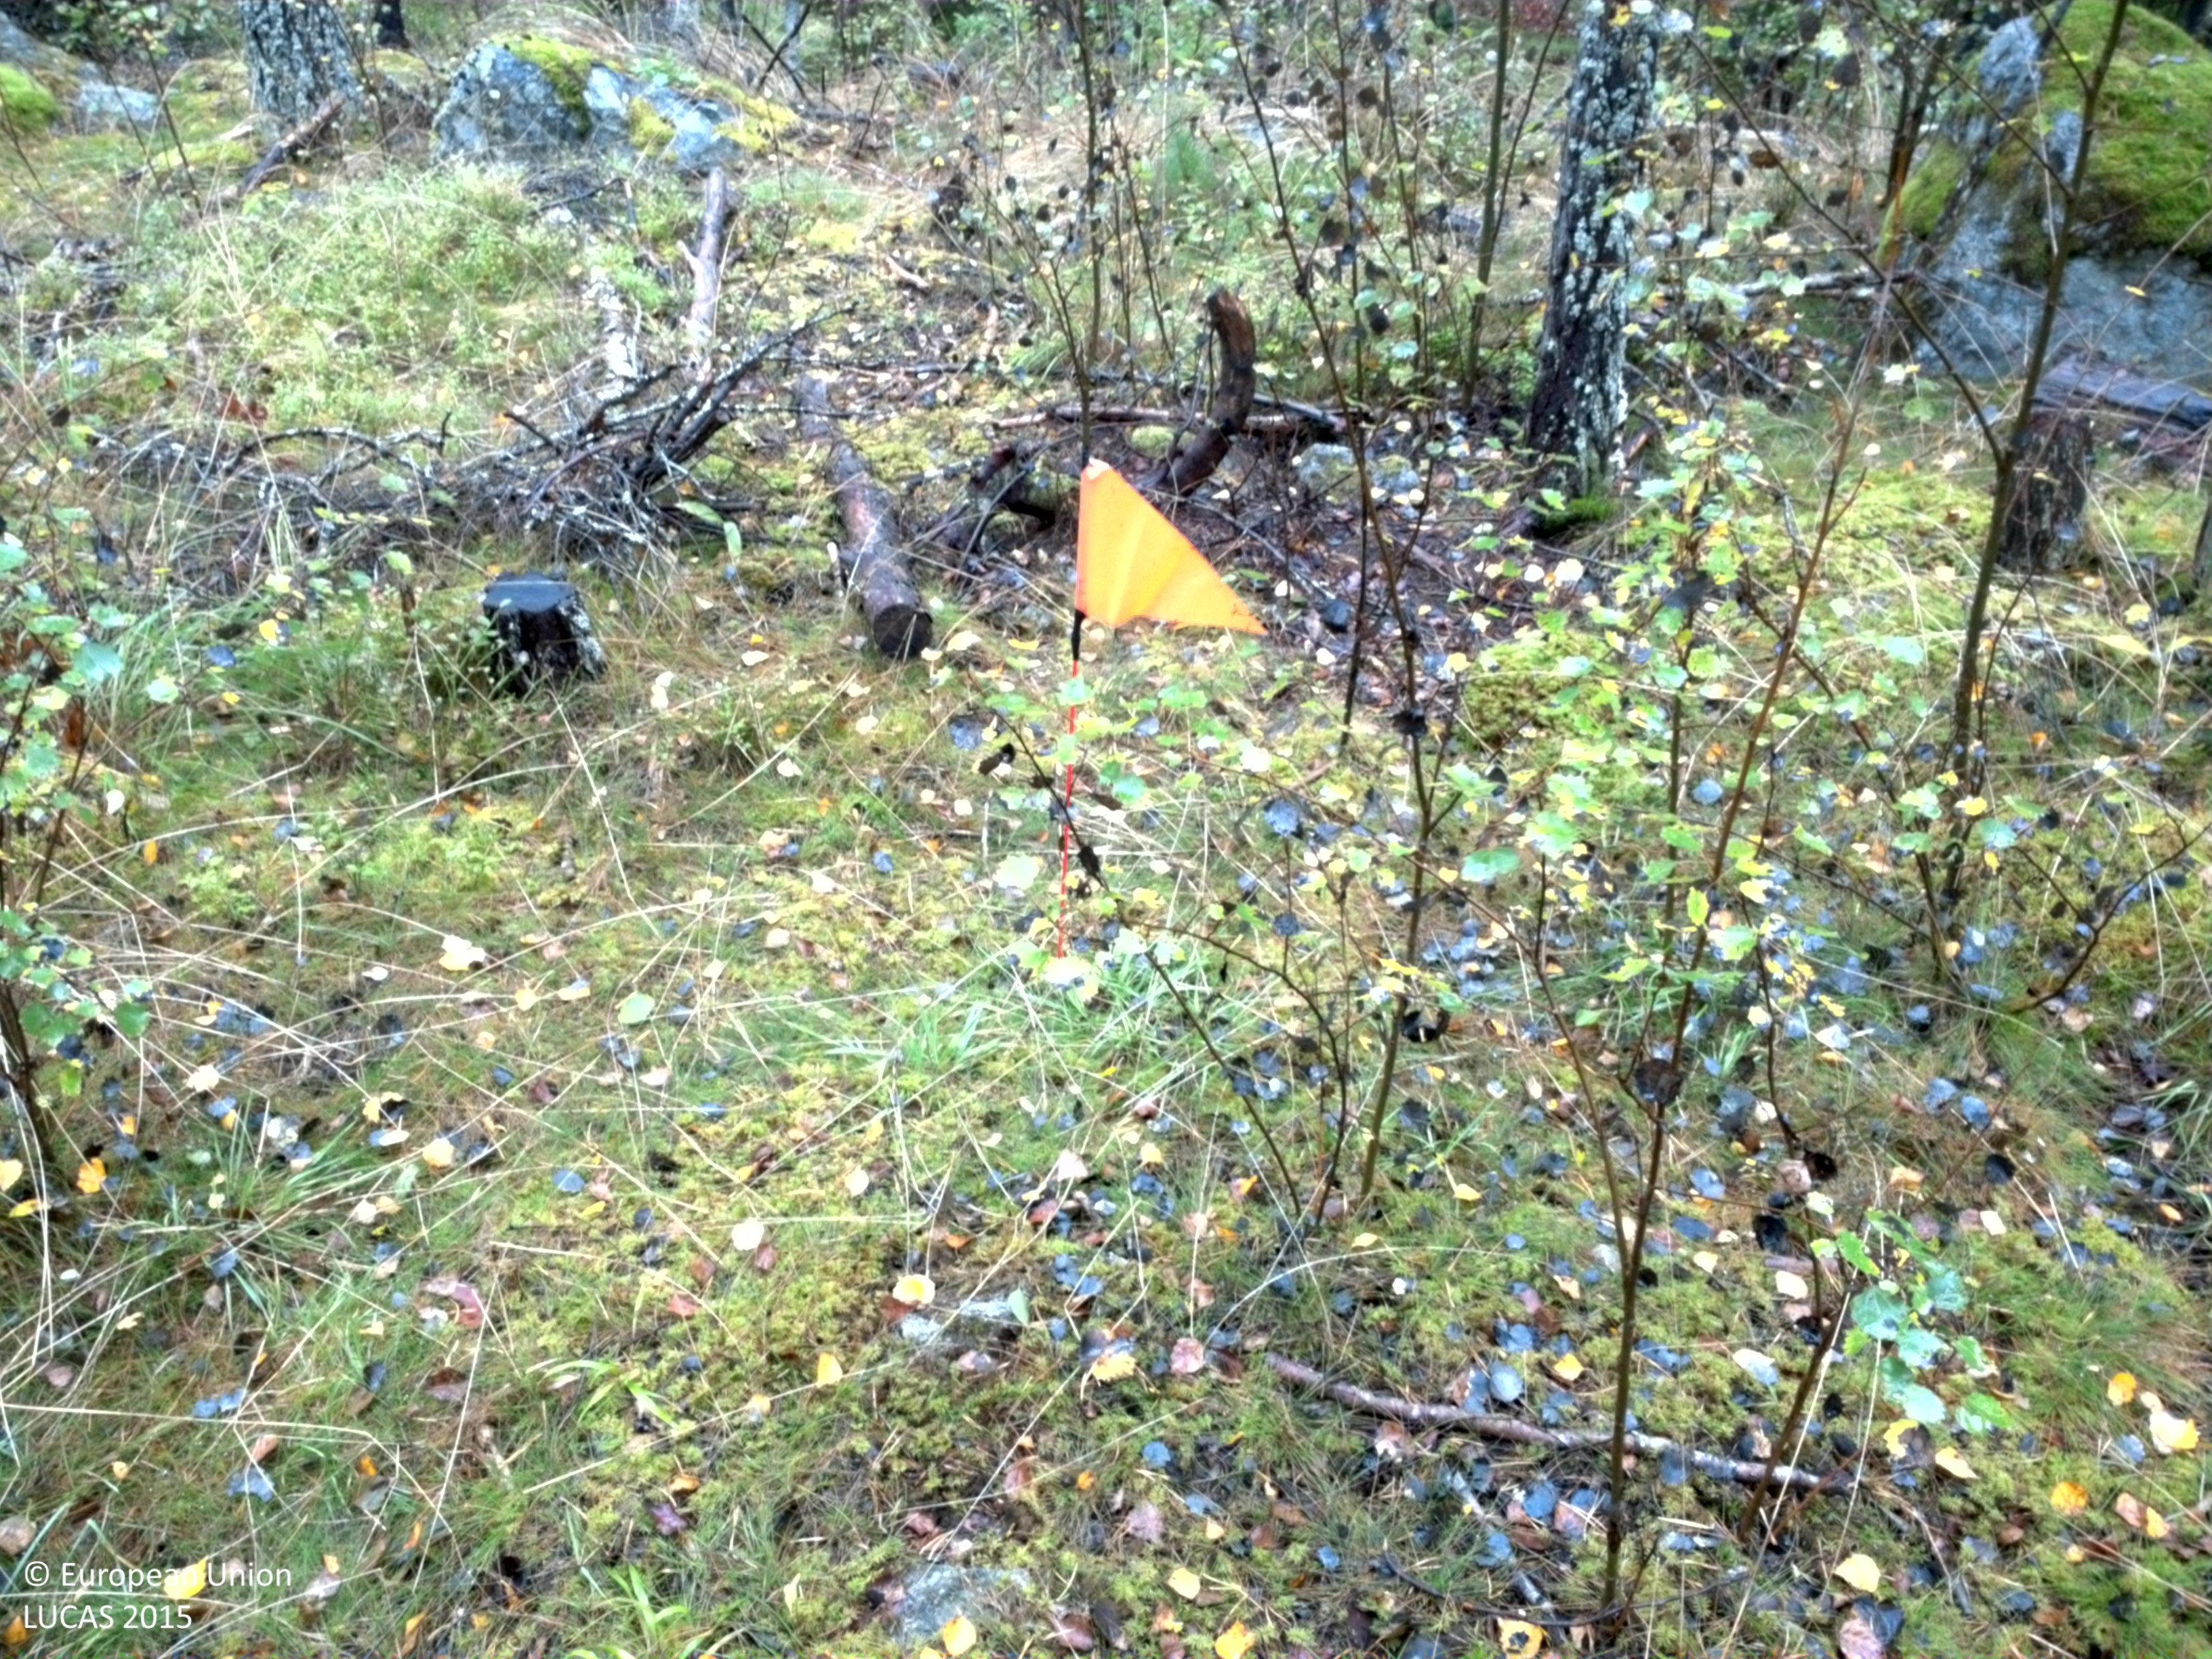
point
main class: Woodland
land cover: Pine dominated mixed woodland
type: boreal forest
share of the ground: 50 - 75 %
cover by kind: coniferous forest trees 40 %, herbaceous plants 30 %, broadleaved forest trees 15 %, shrubs 10 %, lichens and mosses 5 %
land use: Forestry
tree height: > 5 m
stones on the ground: < 10 %
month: September
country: SE
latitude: 59.5823
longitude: 17.8408
